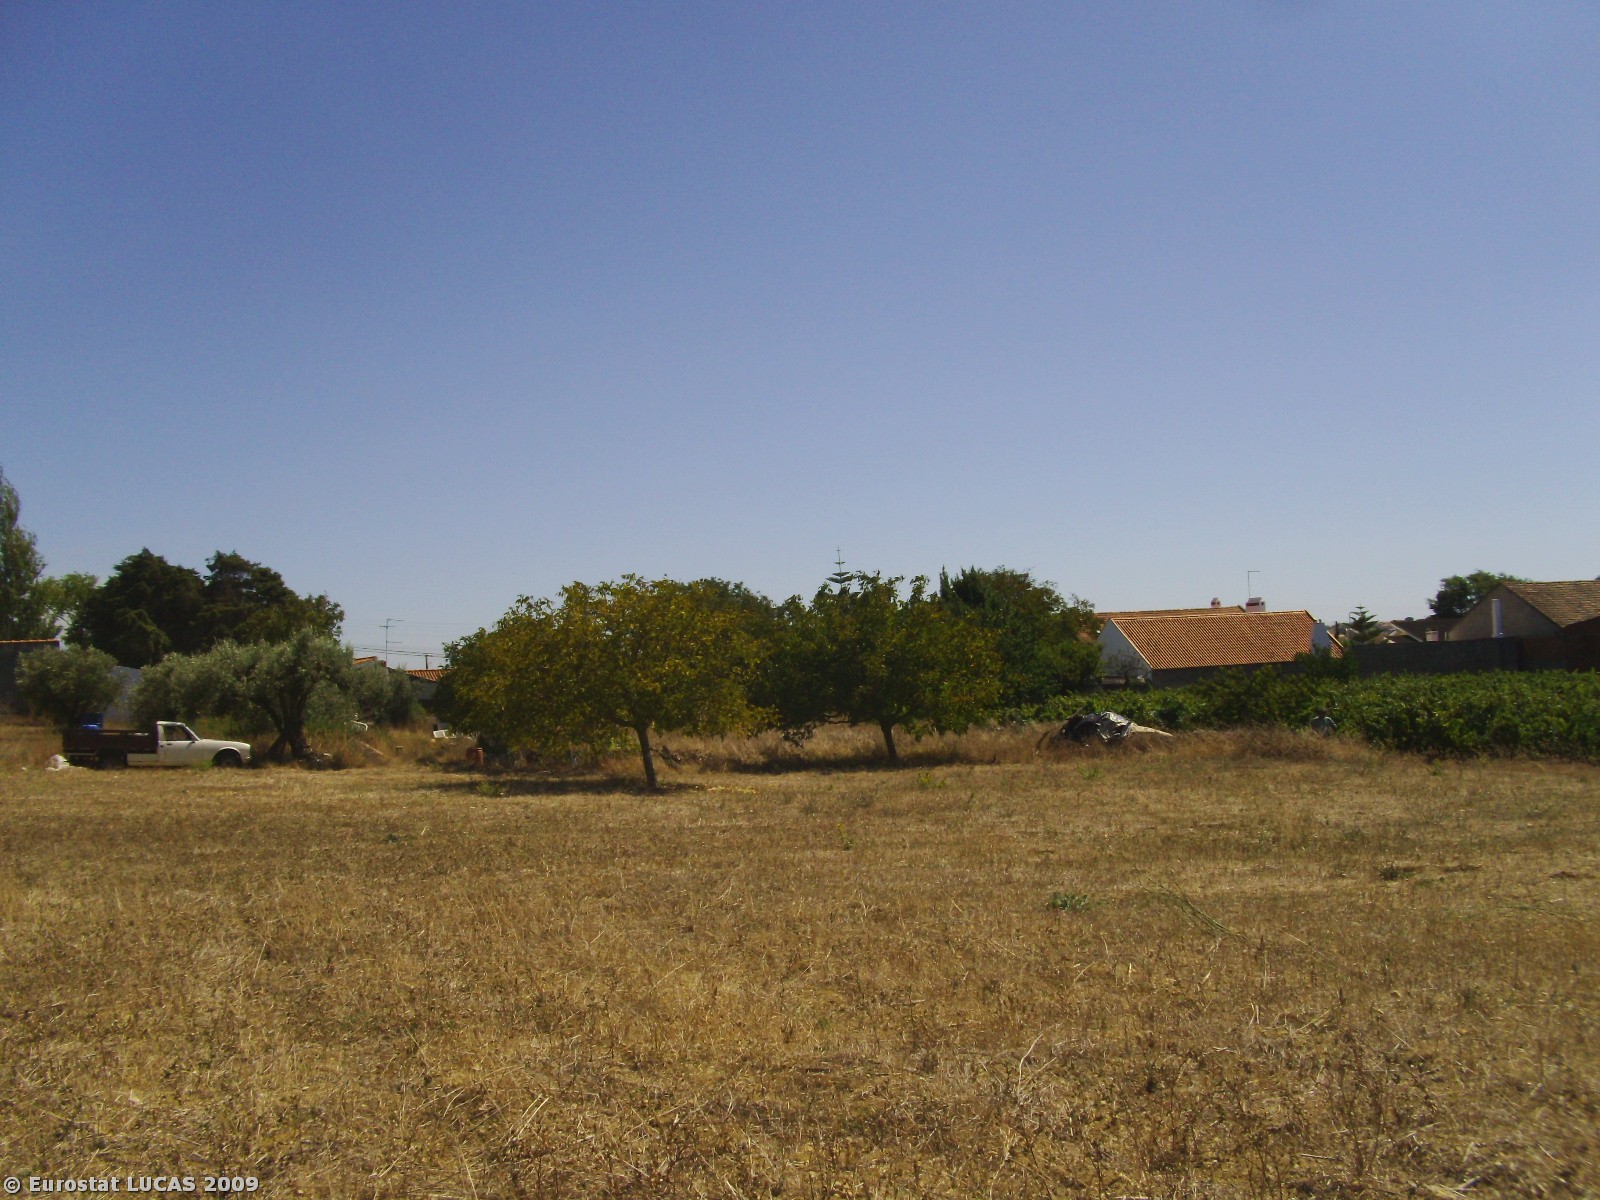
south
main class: Grassland
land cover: Grassland without tree/shrub cover
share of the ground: > 75 %
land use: Agriculture (excluding fallow land and kitchen gardens)
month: July
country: PT
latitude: 39.1779
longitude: -8.8639
